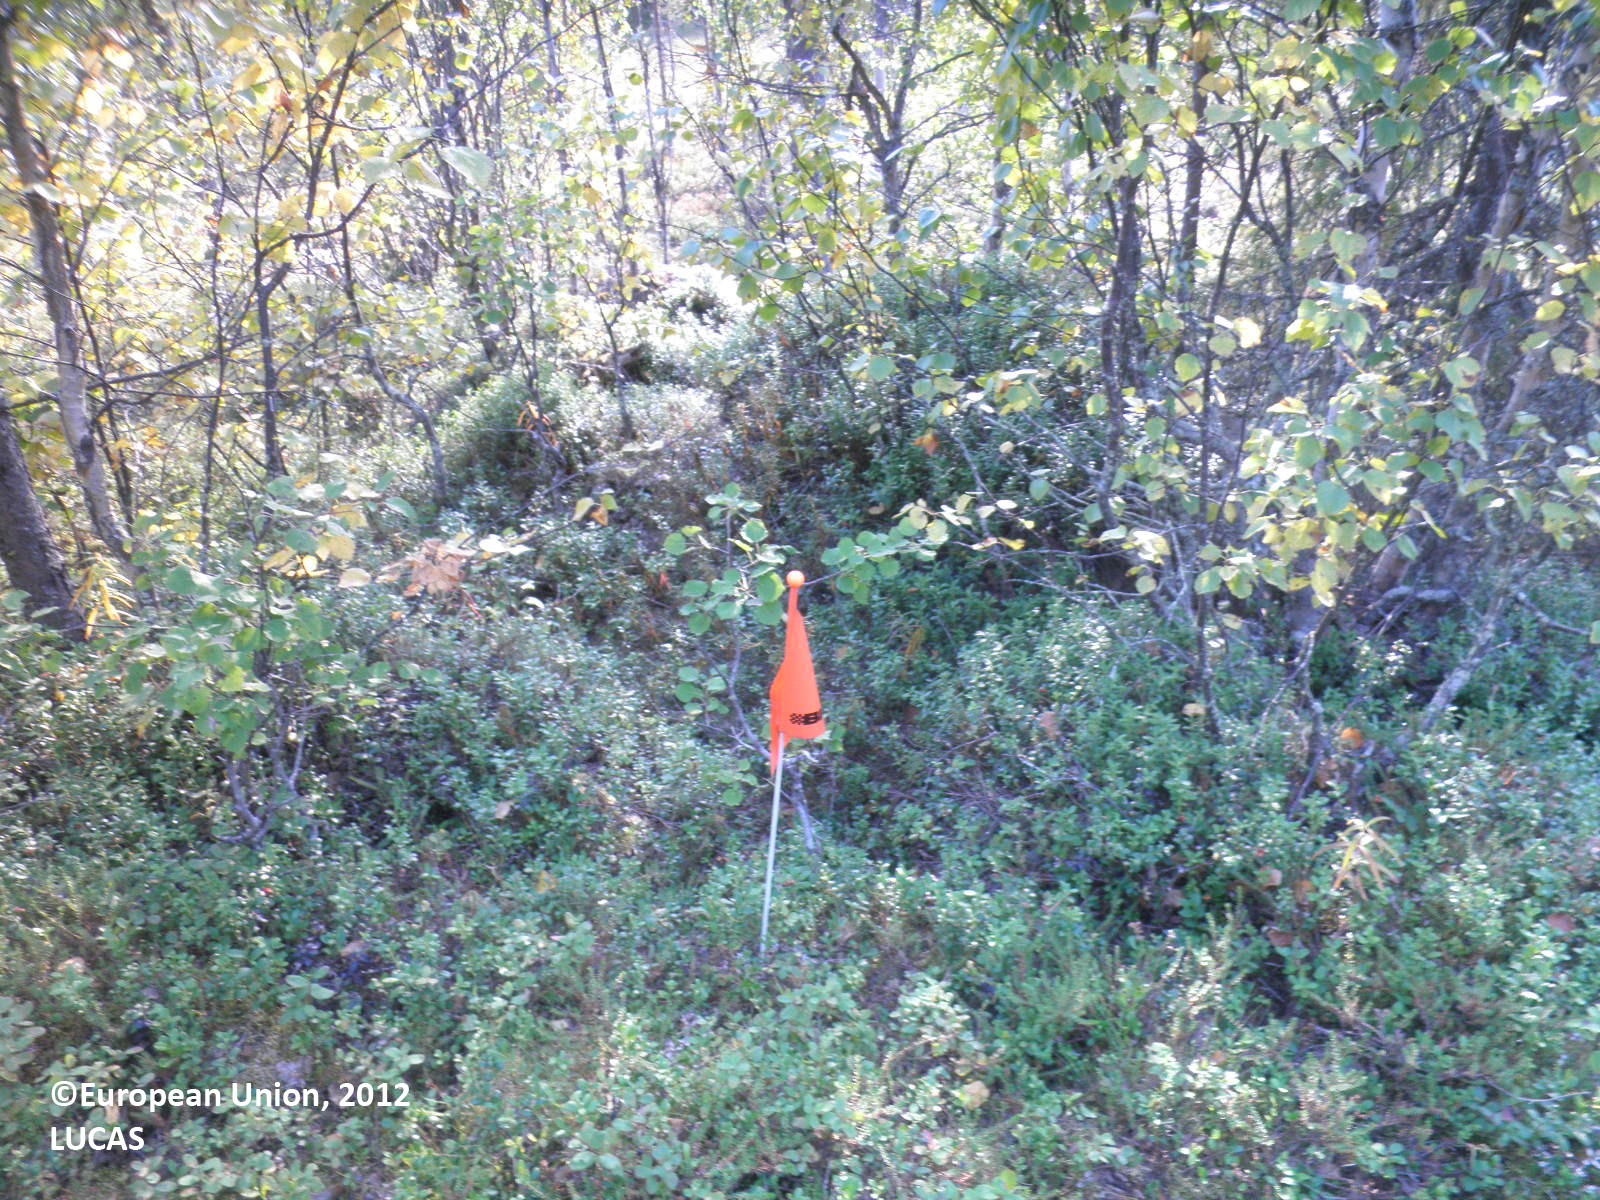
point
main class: Woodland
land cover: Pine dominated mixed woodland
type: boreal forest
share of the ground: 50 - 75 %
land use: Forestry
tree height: > 5 m
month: August
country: FI
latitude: 67.6957
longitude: 27.2041
